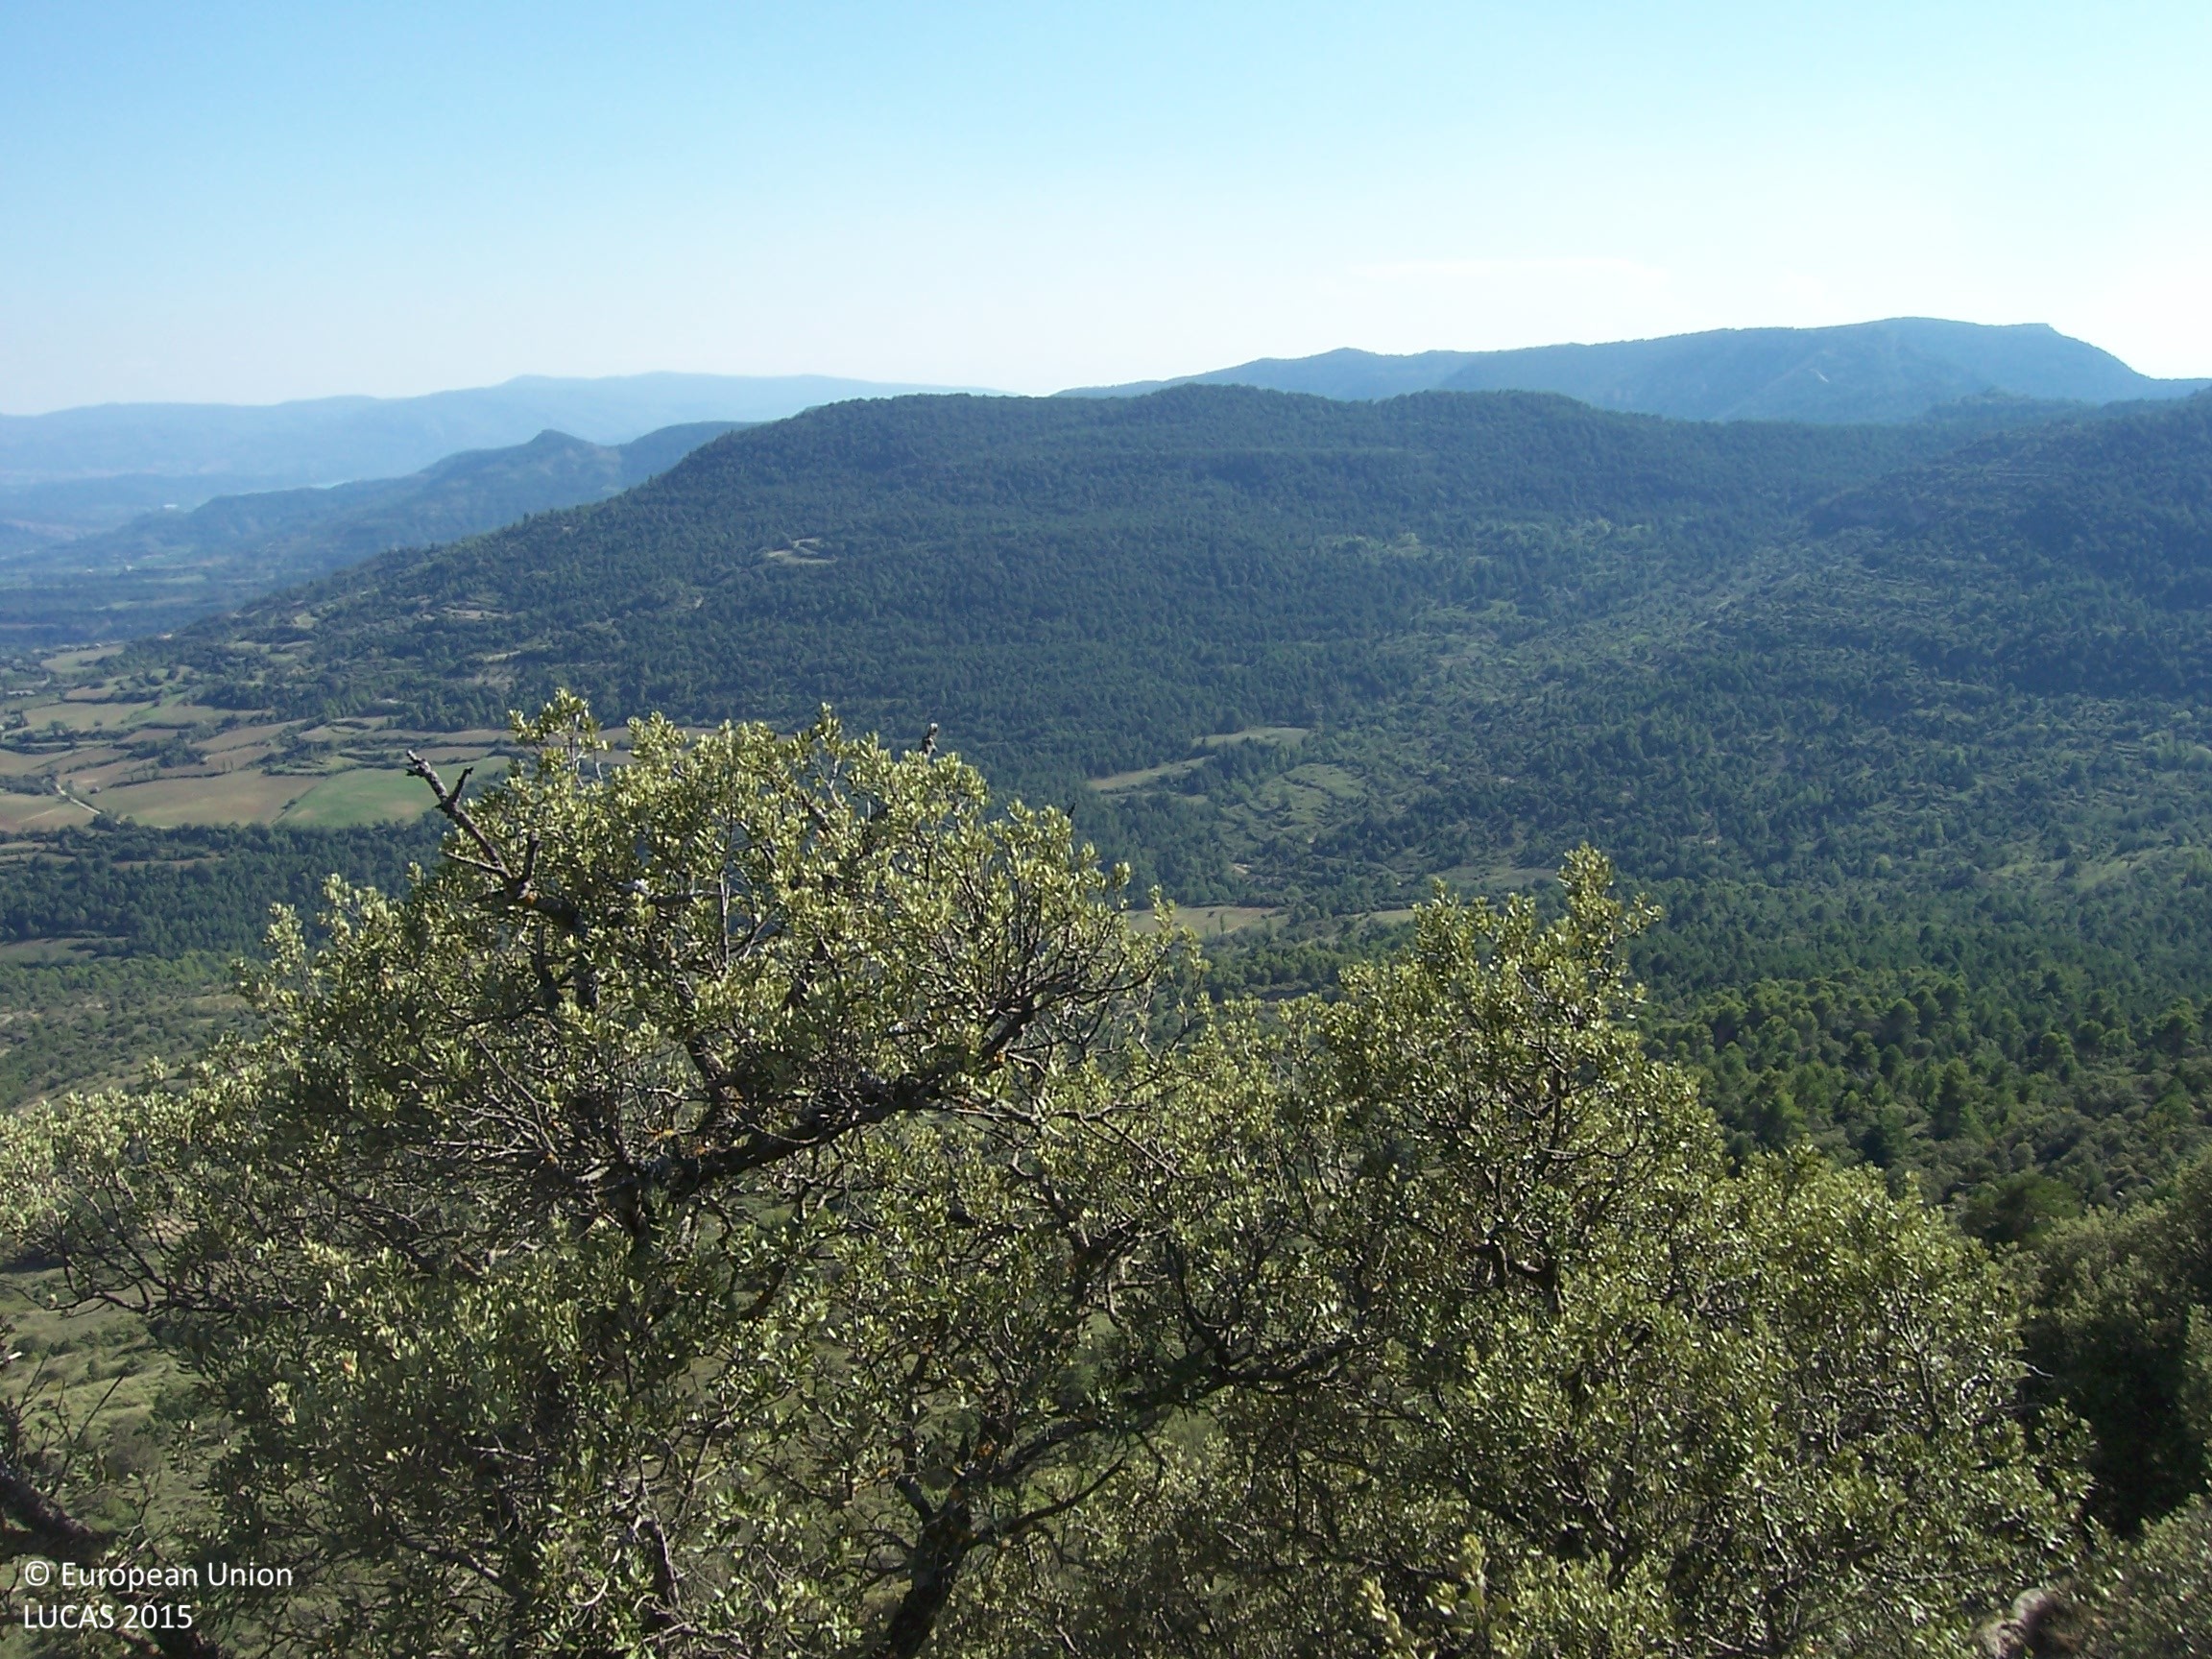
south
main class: Woodland
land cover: Broadleaved woodland
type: broadleaved evergreen forest
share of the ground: 25 - 50 %
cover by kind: broadleaved forest trees 30 %, shrubs 30 %, herbaceous plants 30 %, unconsolidated bare surface 10 %
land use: Semi-natural and natural areas not in use
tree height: < 5 m
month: August
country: ES
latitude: 42.2799
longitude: 0.3164
